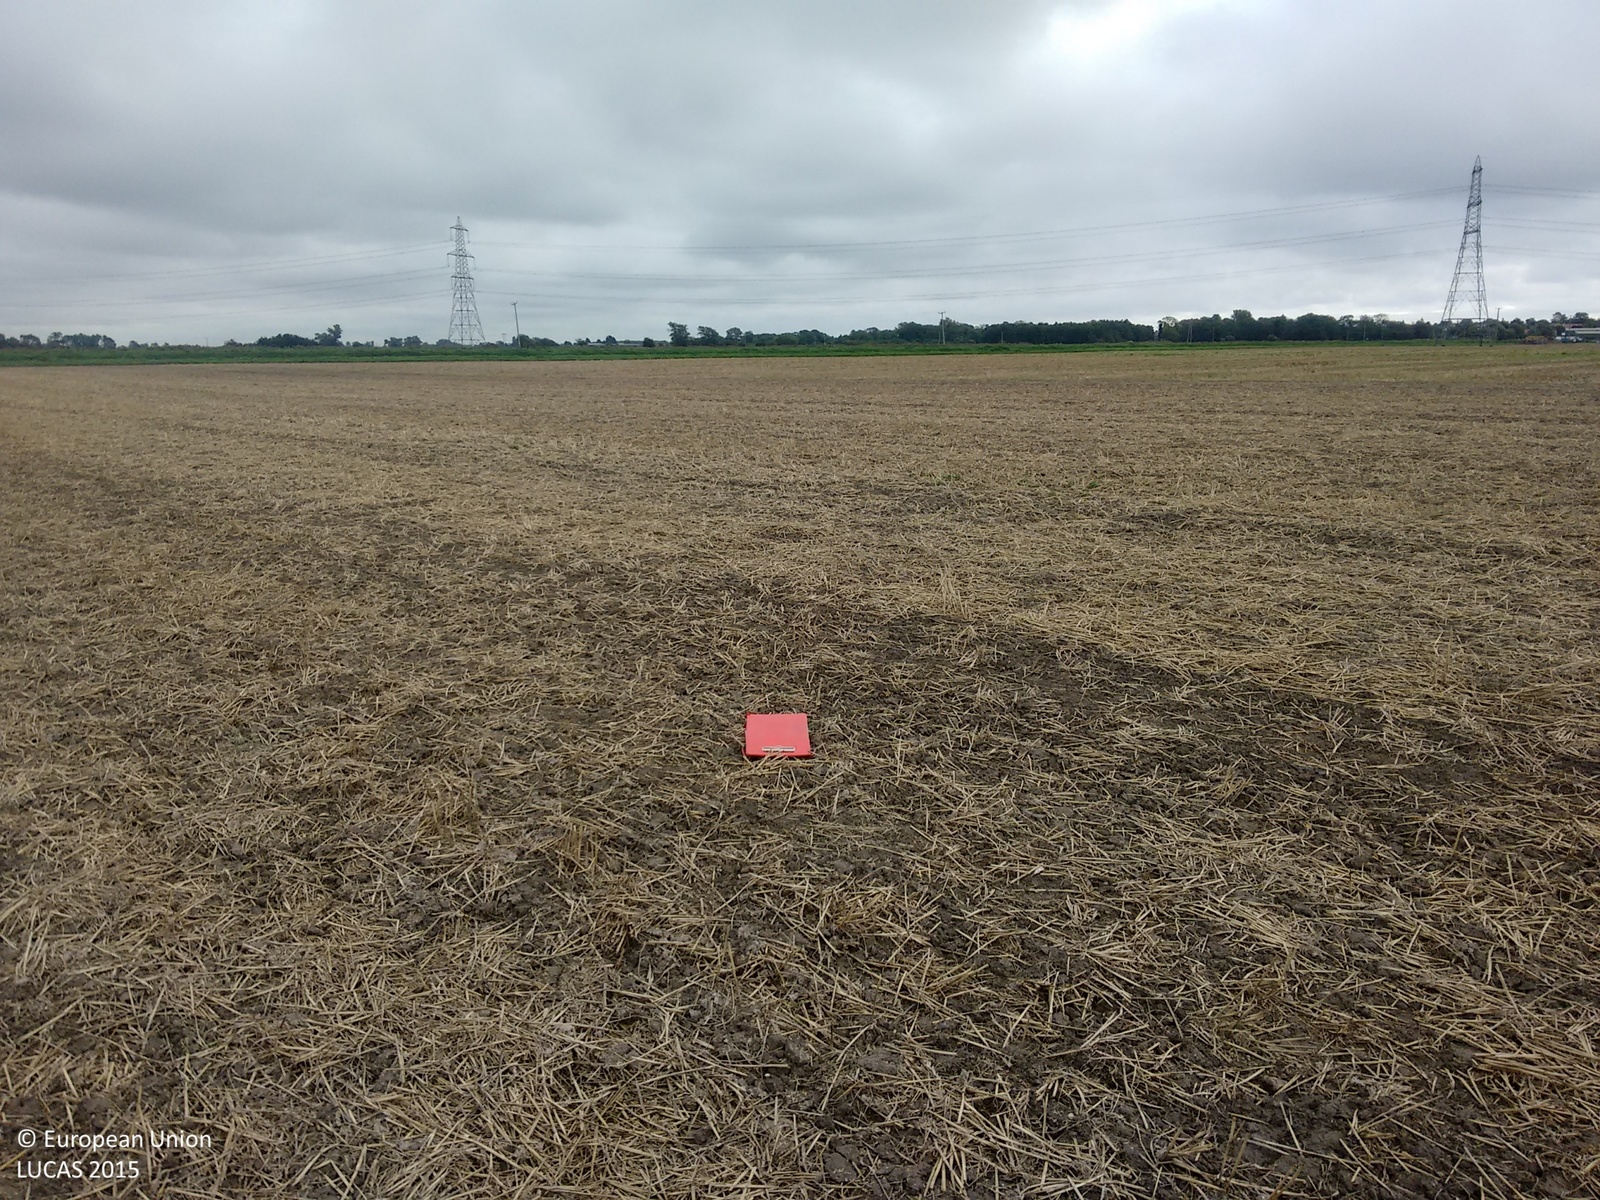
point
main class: Cropland
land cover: Common wheat
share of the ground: 25 - 50 %
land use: Agriculture (excluding fallow land and kitchen gardens)
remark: Harvested field
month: September
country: GB
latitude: 52.2880
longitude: 0.3094
